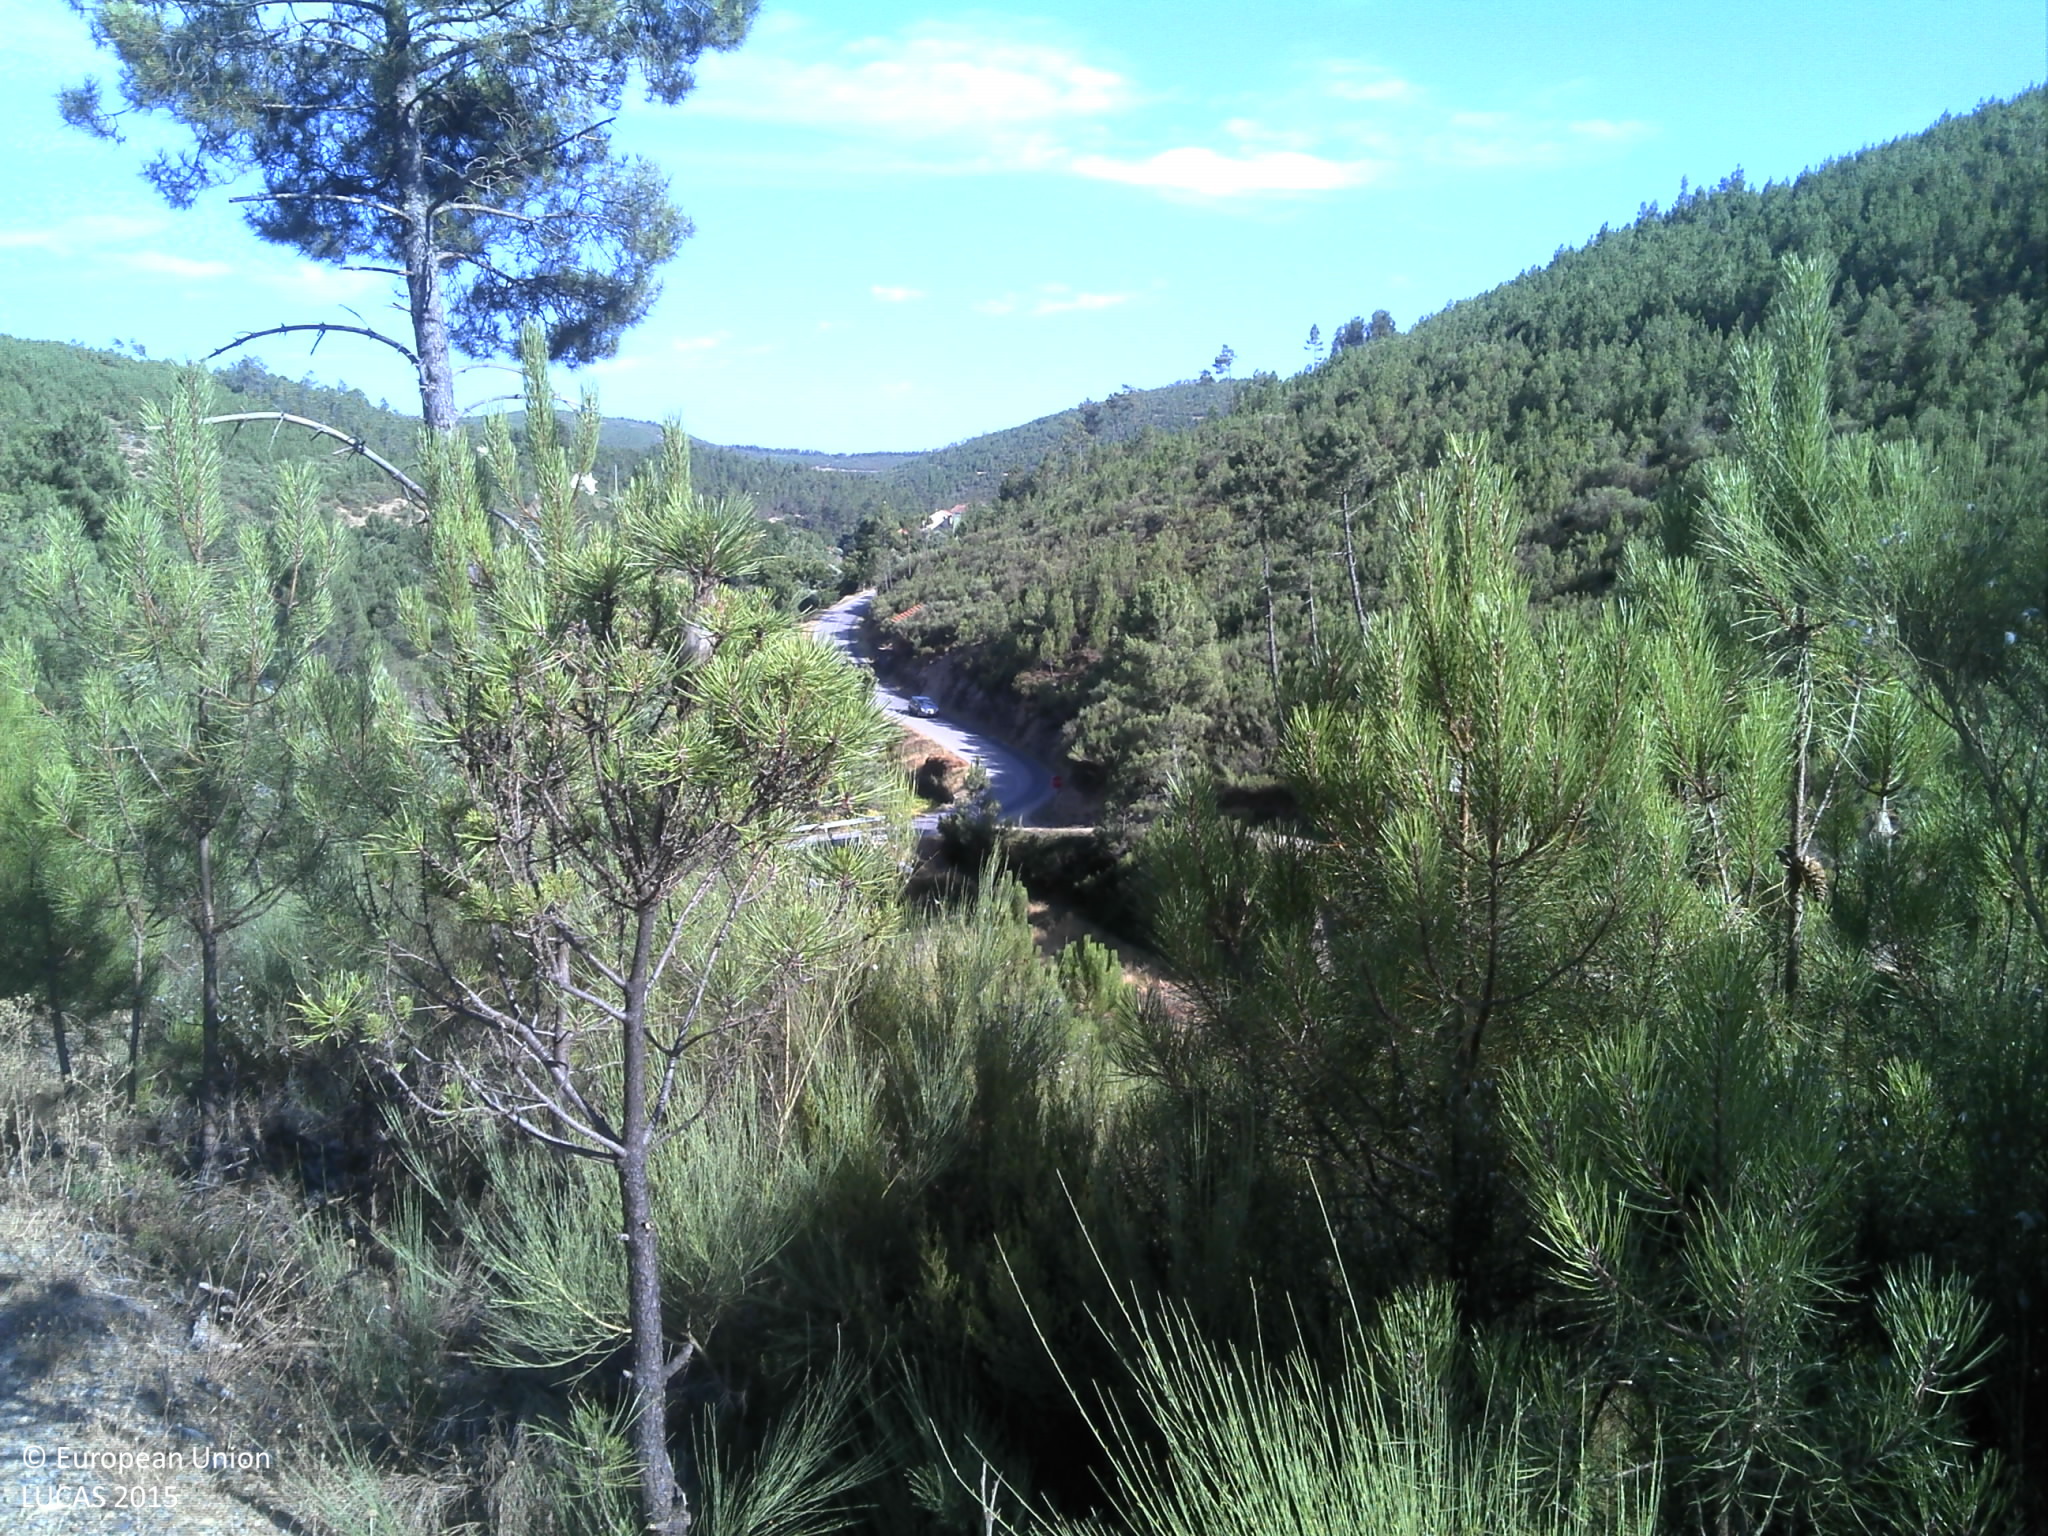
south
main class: Shrubland
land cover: Shrubland without tree cover
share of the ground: > 75 %
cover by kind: shrubs 90 %, unconsolidated bare surface 5 %
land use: Abandoned areas
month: July
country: PT
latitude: 40.1309
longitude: -7.8460
